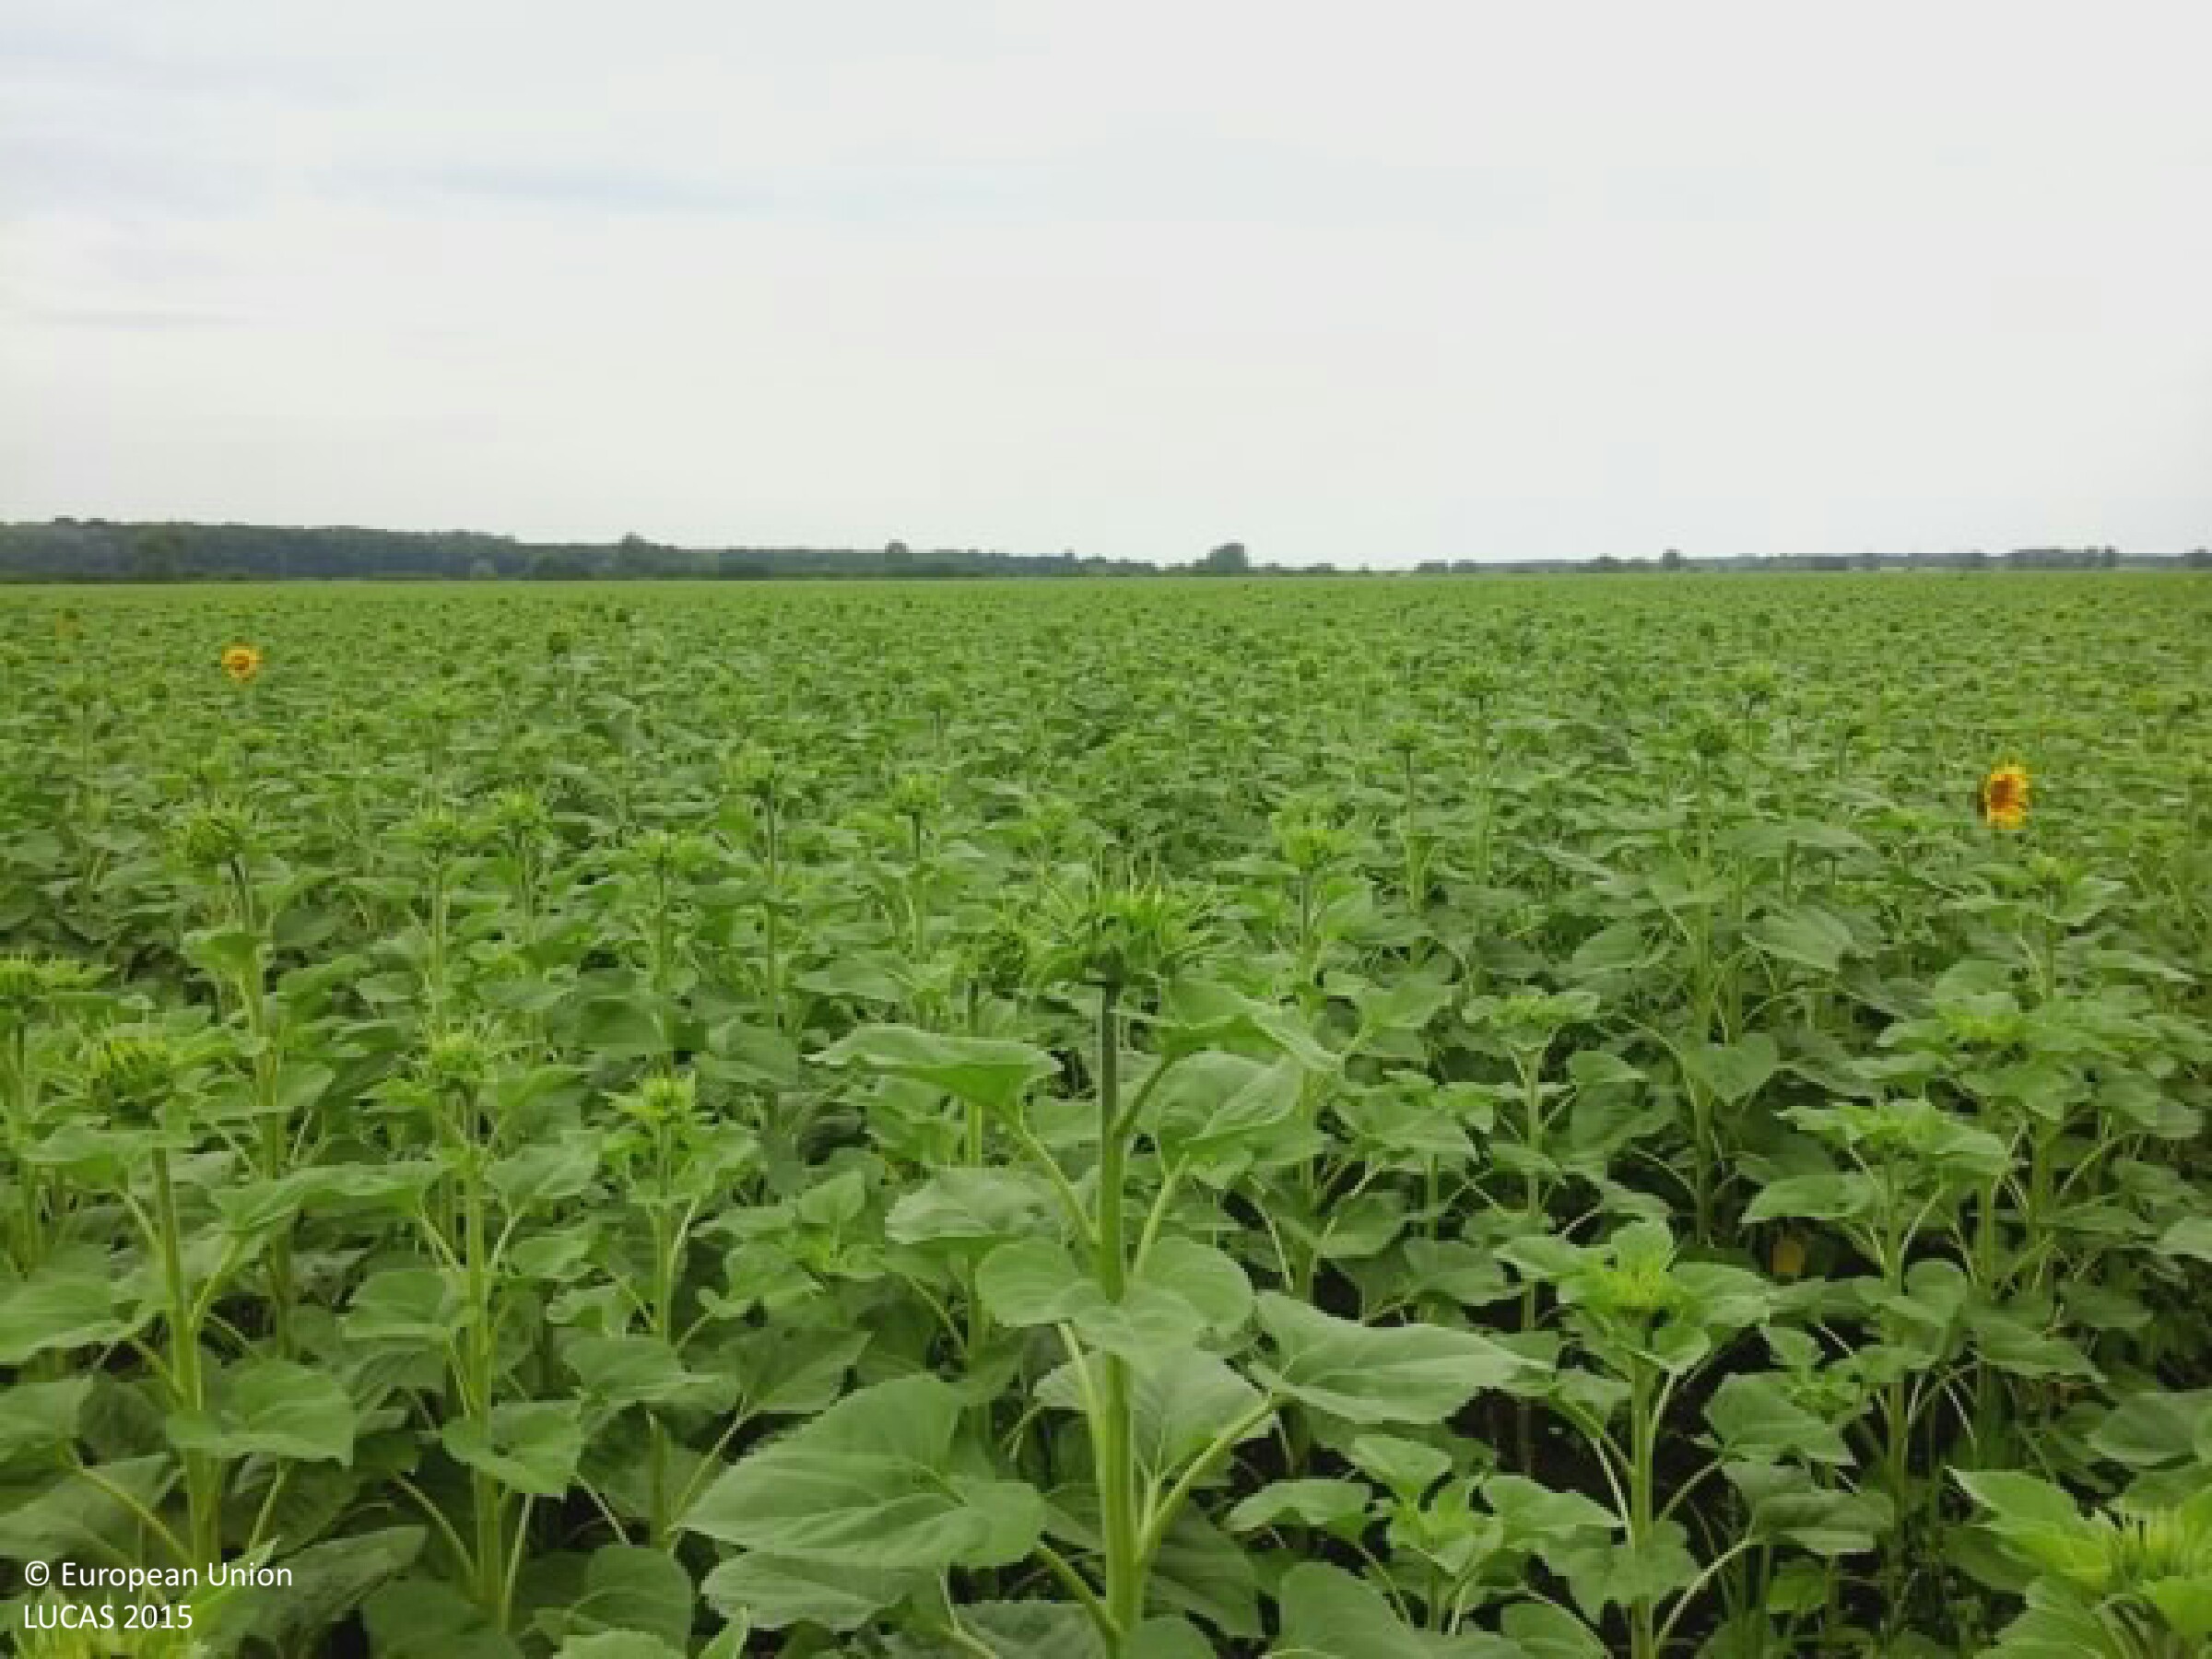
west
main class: Cropland
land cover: Sunflower
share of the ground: > 75 %
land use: Agriculture (excluding fallow land and kitchen gardens)
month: June
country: HU
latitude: 46.5227
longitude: 20.1256
